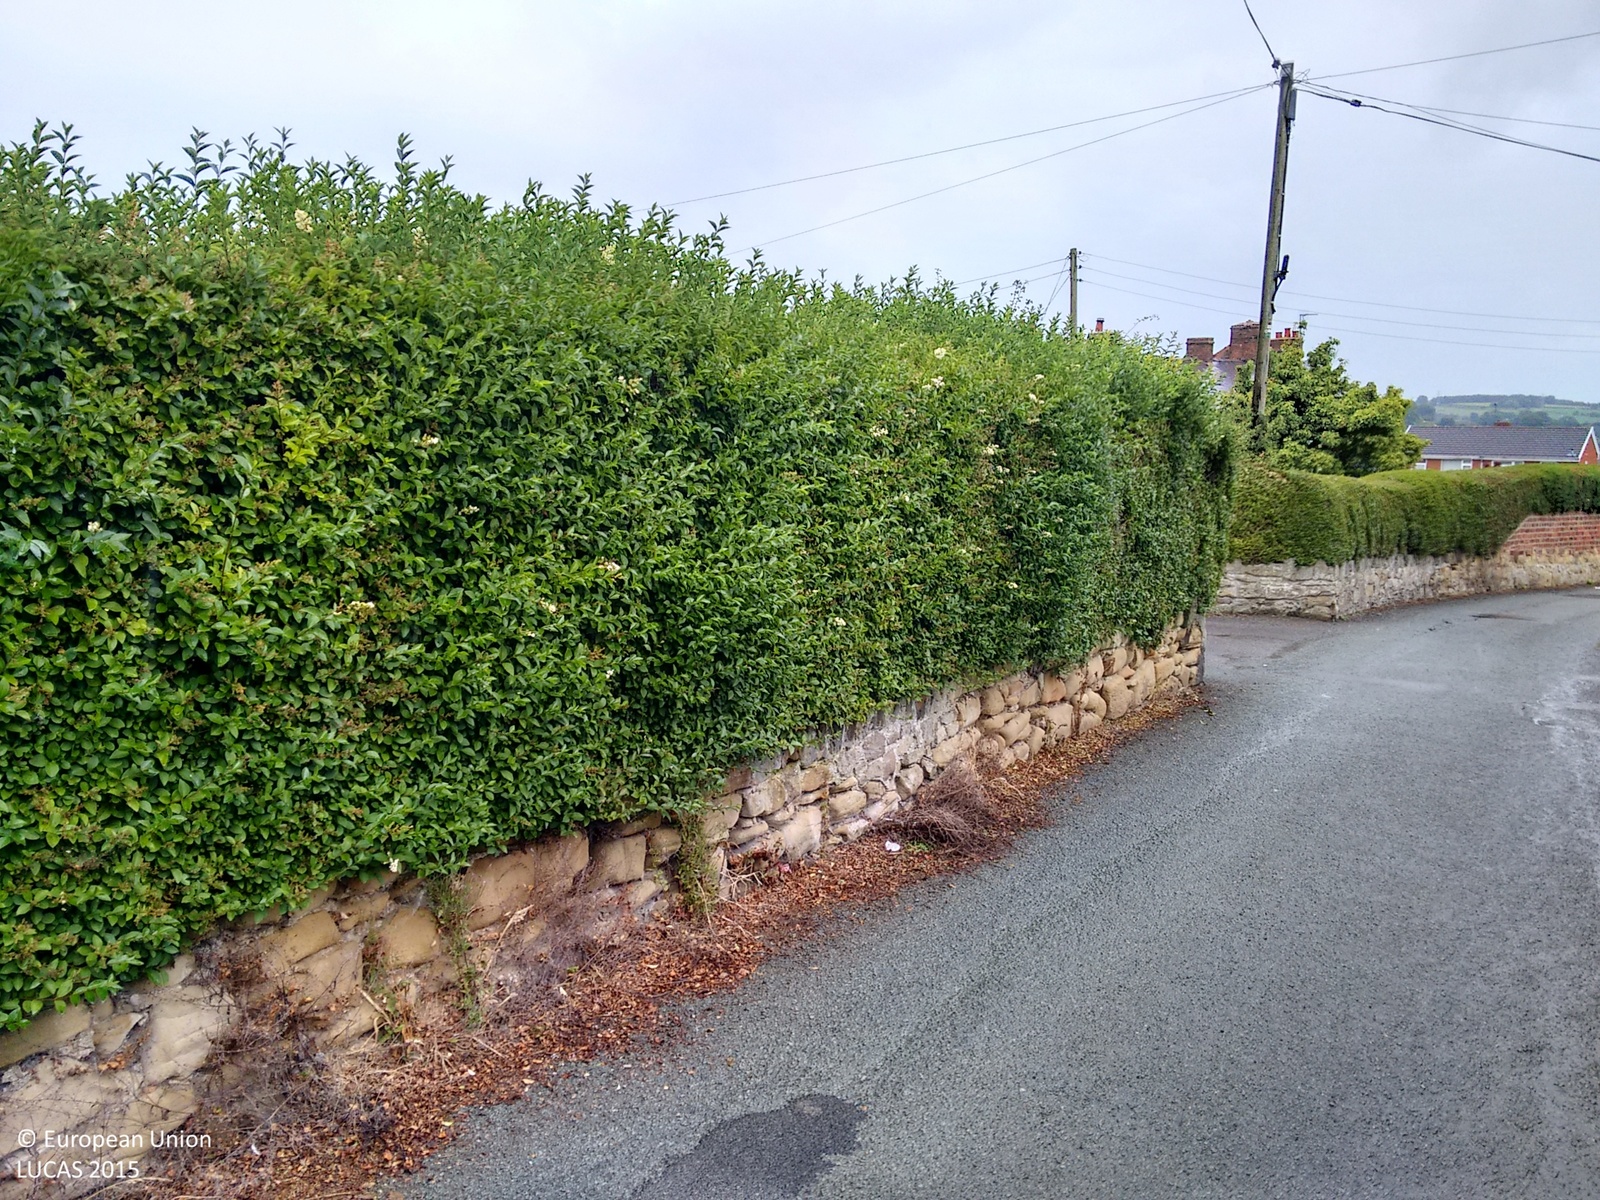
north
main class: Shrubland
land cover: Shrubland without tree cover
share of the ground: > 75 %
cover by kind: shrubs 100 %
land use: Semi-natural and natural areas not in use
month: September
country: GB
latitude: 53.0540
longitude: -3.0706
